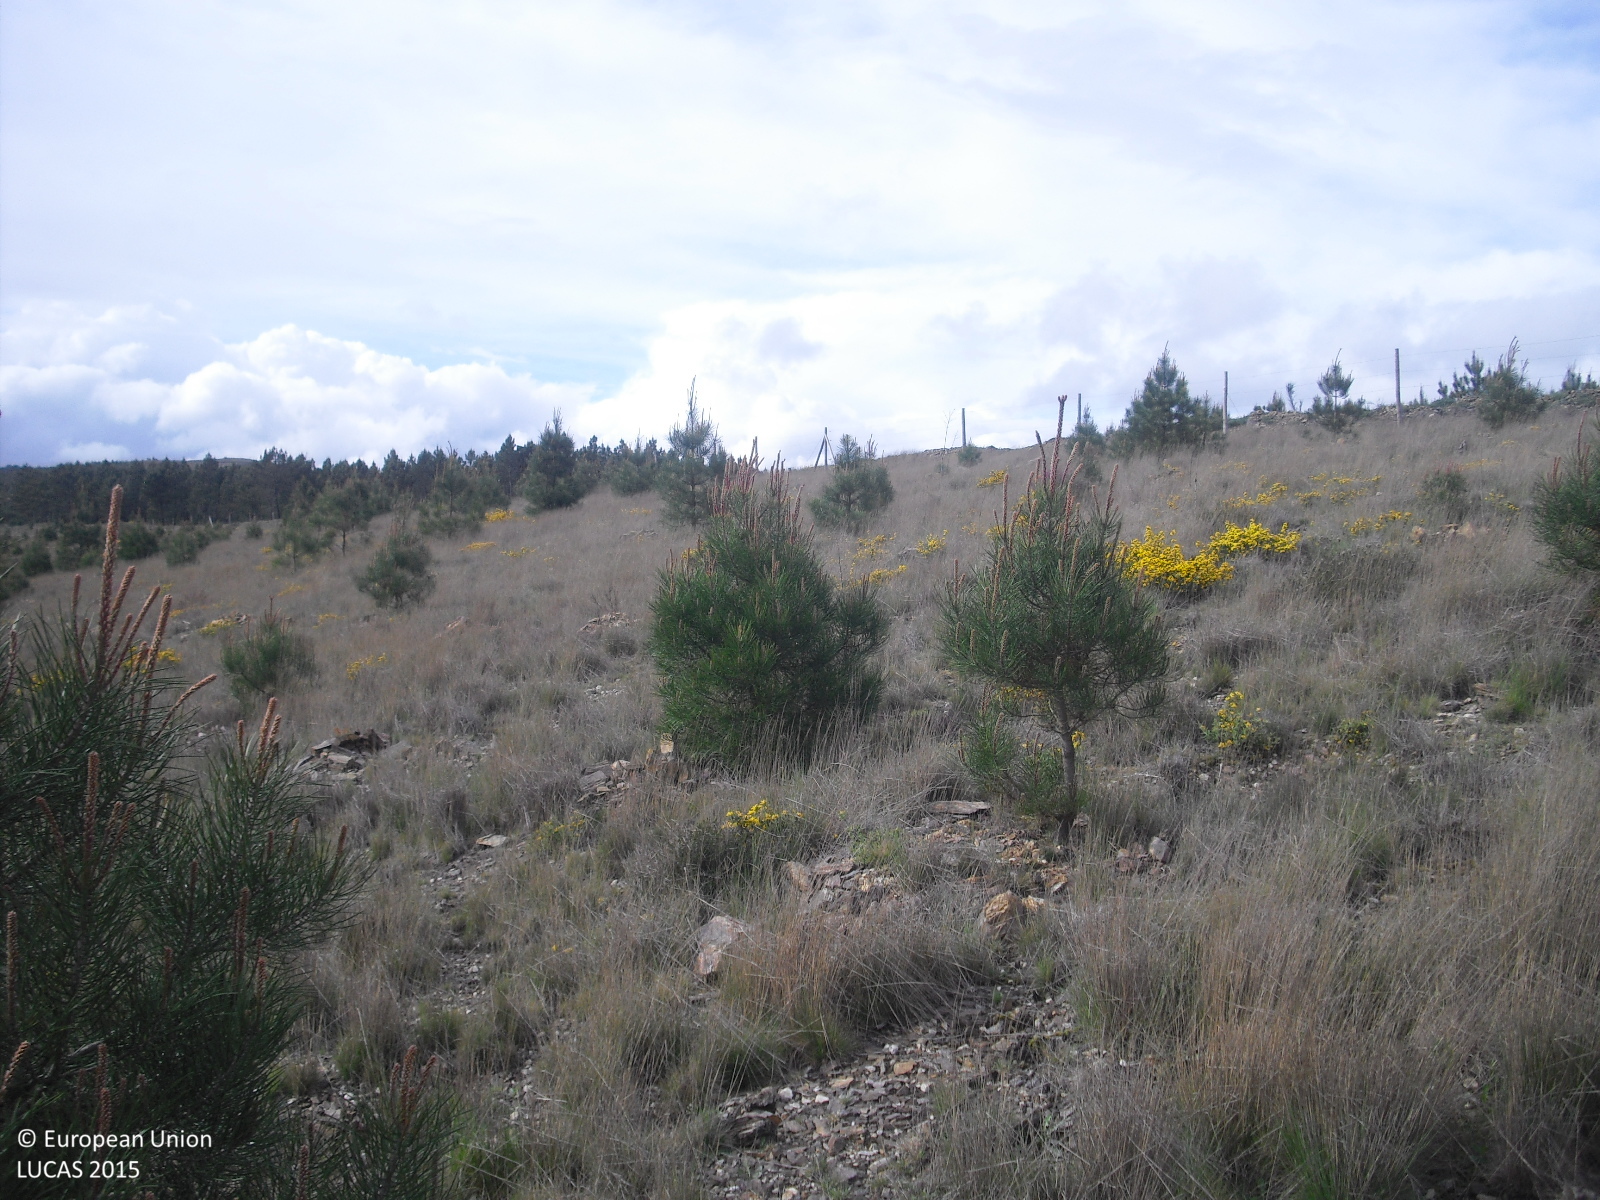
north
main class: Woodland
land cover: Pine dominated coniferous woodland
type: exotic forest
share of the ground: 10 - 25 %
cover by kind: shrubs 30 %, herbaceous plants 30 %, unconsolidated bare surface 30 %, coniferous forest trees 10 %
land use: Forestry
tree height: < 5 m
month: April
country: ES
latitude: 41.9958
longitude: -7.5314
